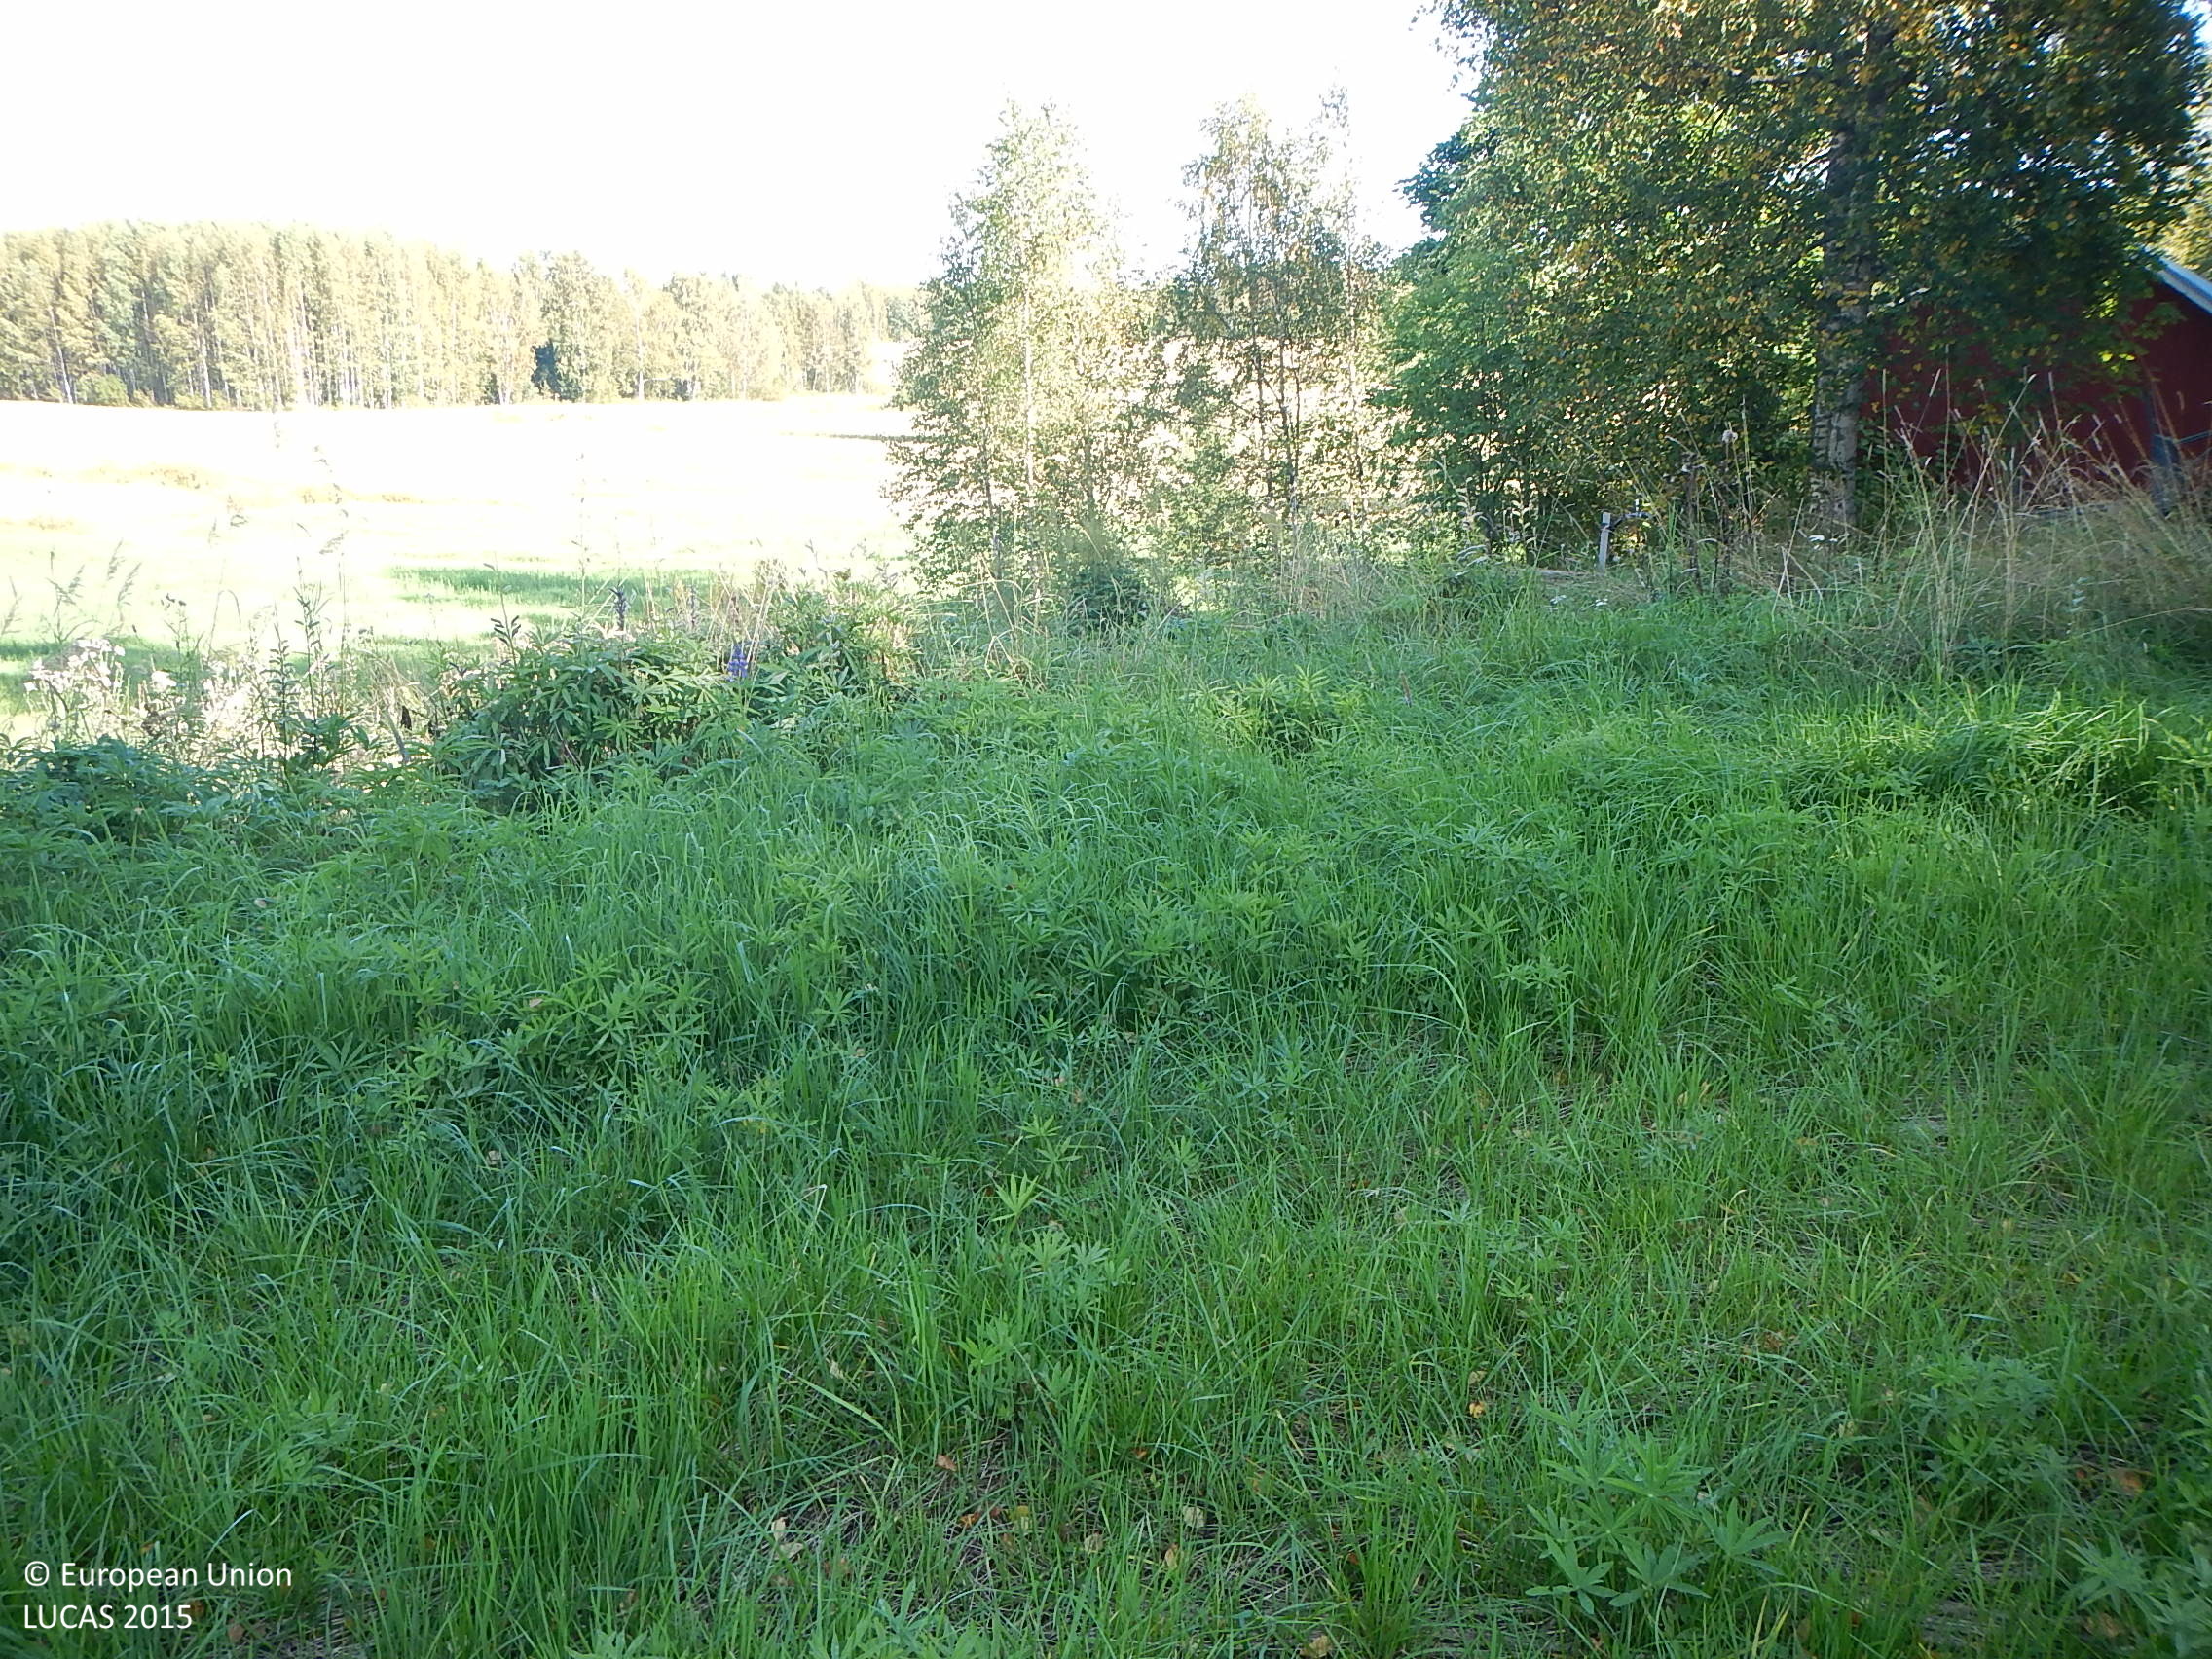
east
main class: Grassland
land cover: Grassland without tree/shrub cover
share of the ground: > 75 %
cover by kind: herbaceous plants 100 %
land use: Agriculture (excluding fallow land and kitchen gardens)
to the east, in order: Grassland without tree/shrub cover; Spontaneously vegetated surfaces; Broadleaved woodland; Ditches and canals; Grassland without tree/shrub cover; Ditches and canals; Grassland without tree/shrub cover; Ditches and canals; Grass margins; Oats; Grass margins; Ditches and canals; Grass margins; Oats
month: September
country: FI
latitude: 61.5567
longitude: 22.7330
